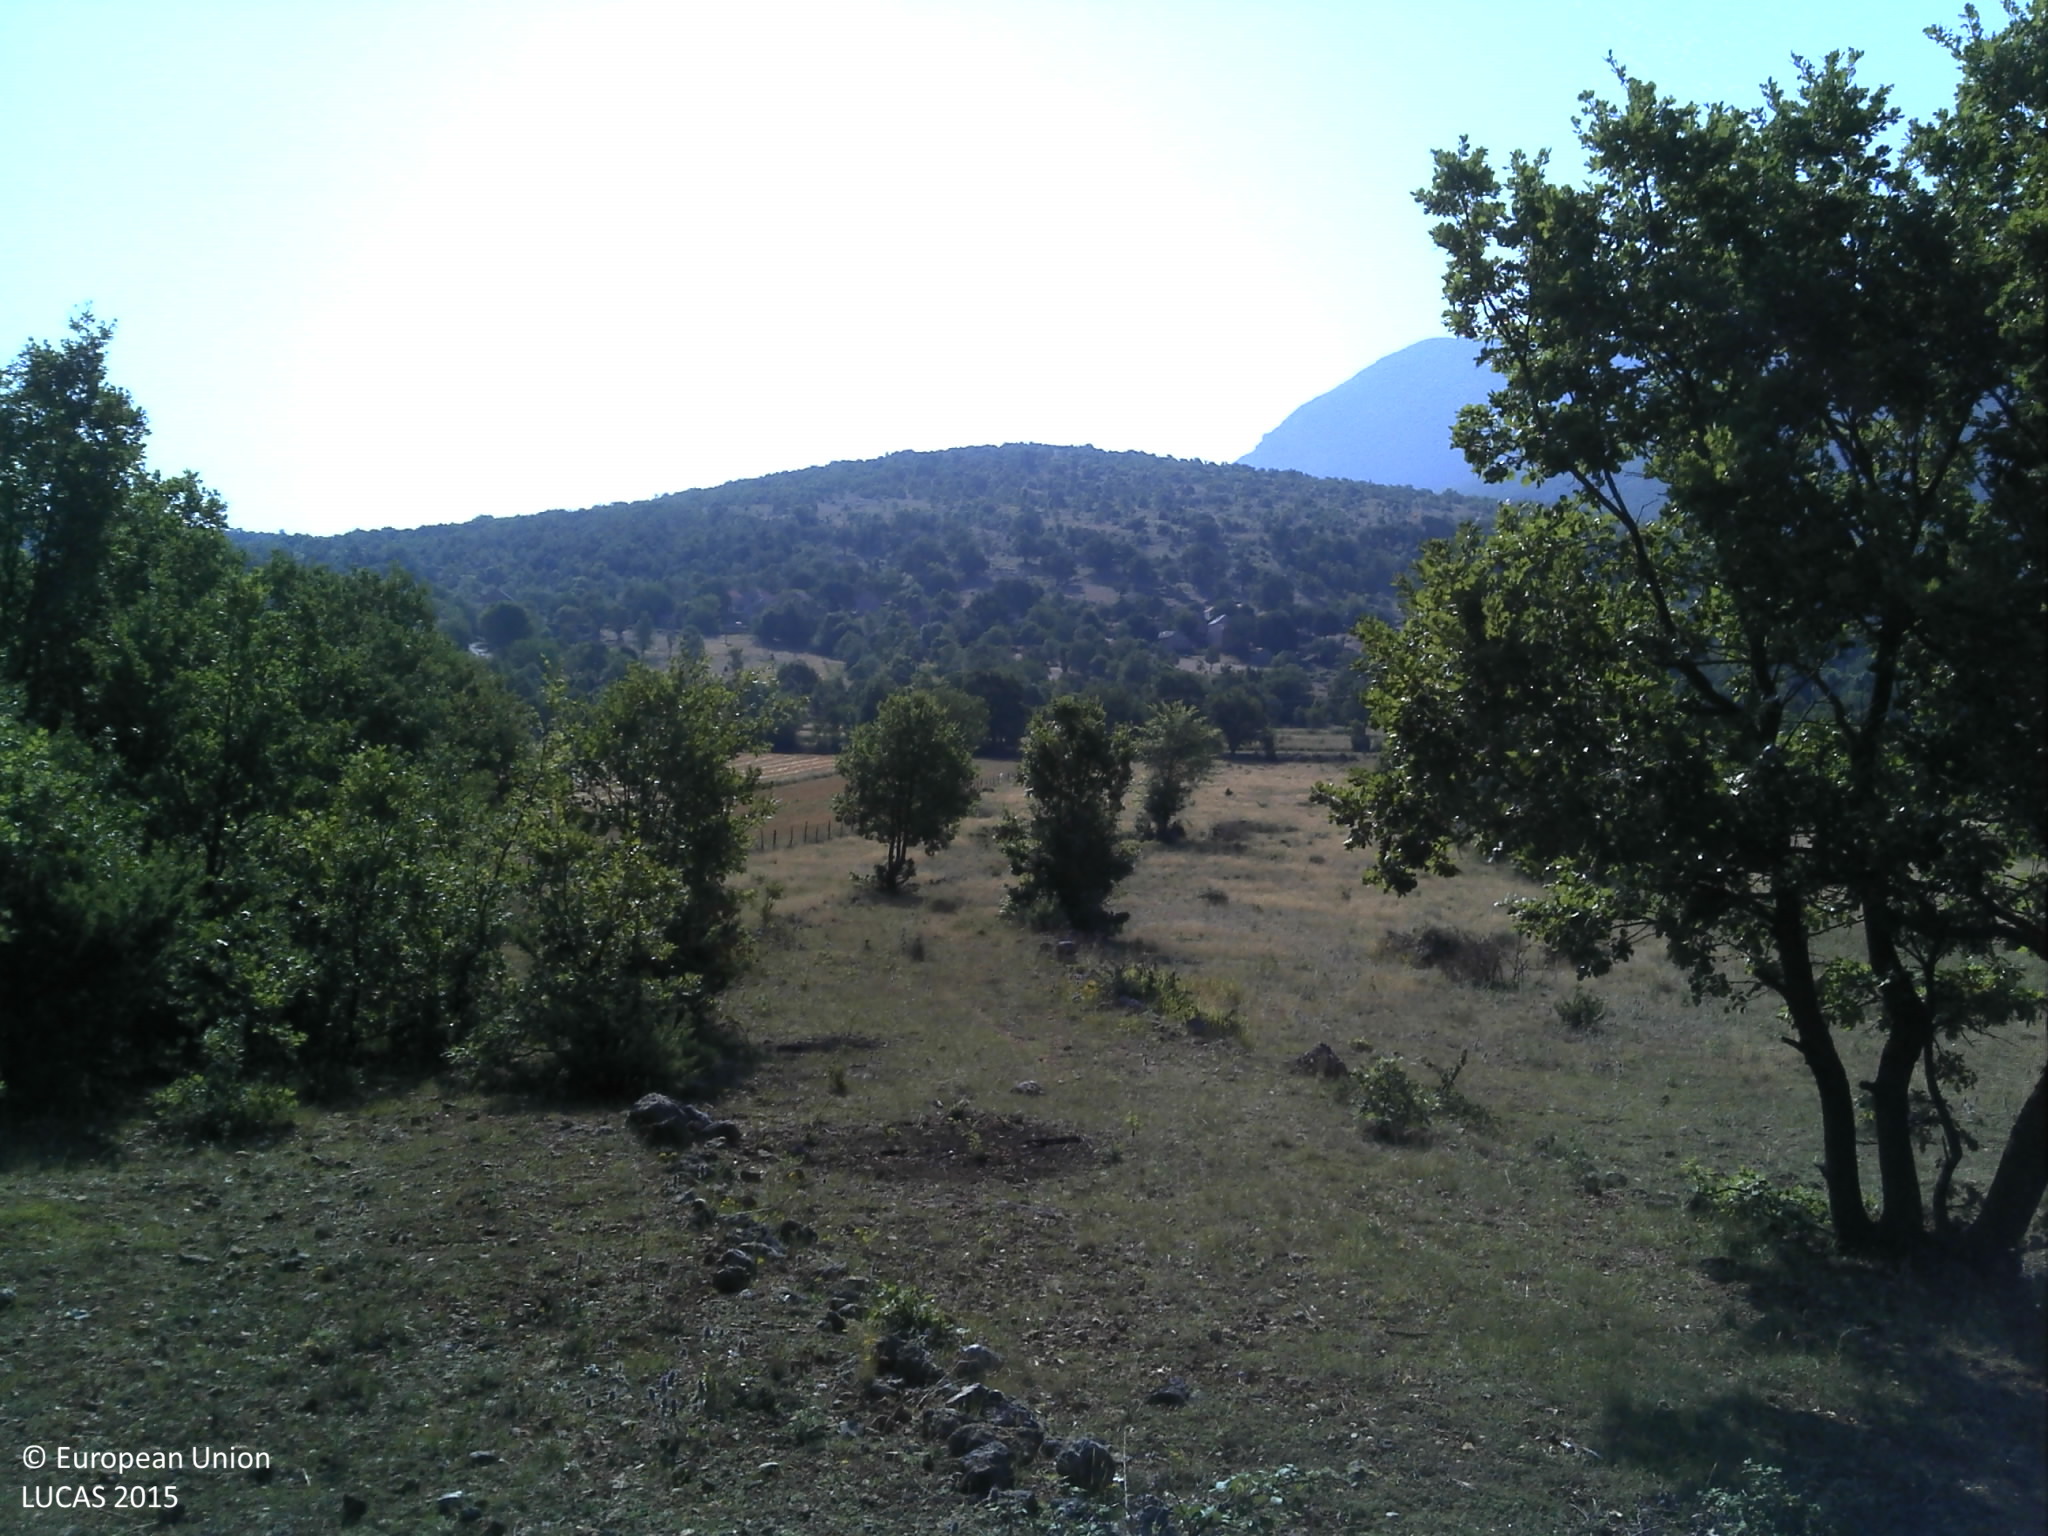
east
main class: Woodland
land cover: Broadleaved woodland
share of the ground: 25 - 50 %
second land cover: Grassland without tree/shrub cover
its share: 50 - 75 %
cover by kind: herbaceous plants 50 %, broadleaved forest trees 30 %, shrubs 20 %
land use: Forestry
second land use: Agriculture (excluding fallow land and kitchen gardens)
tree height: > 5 m
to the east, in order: Broadleaved woodland; Grassland without tree/shrub cover; Shruby margins; Dry stone walls; Grassland with sparse tree/shrub cover; Fences; Common wheat; Barley
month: July
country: HR
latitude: 43.9789
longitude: 16.2880
